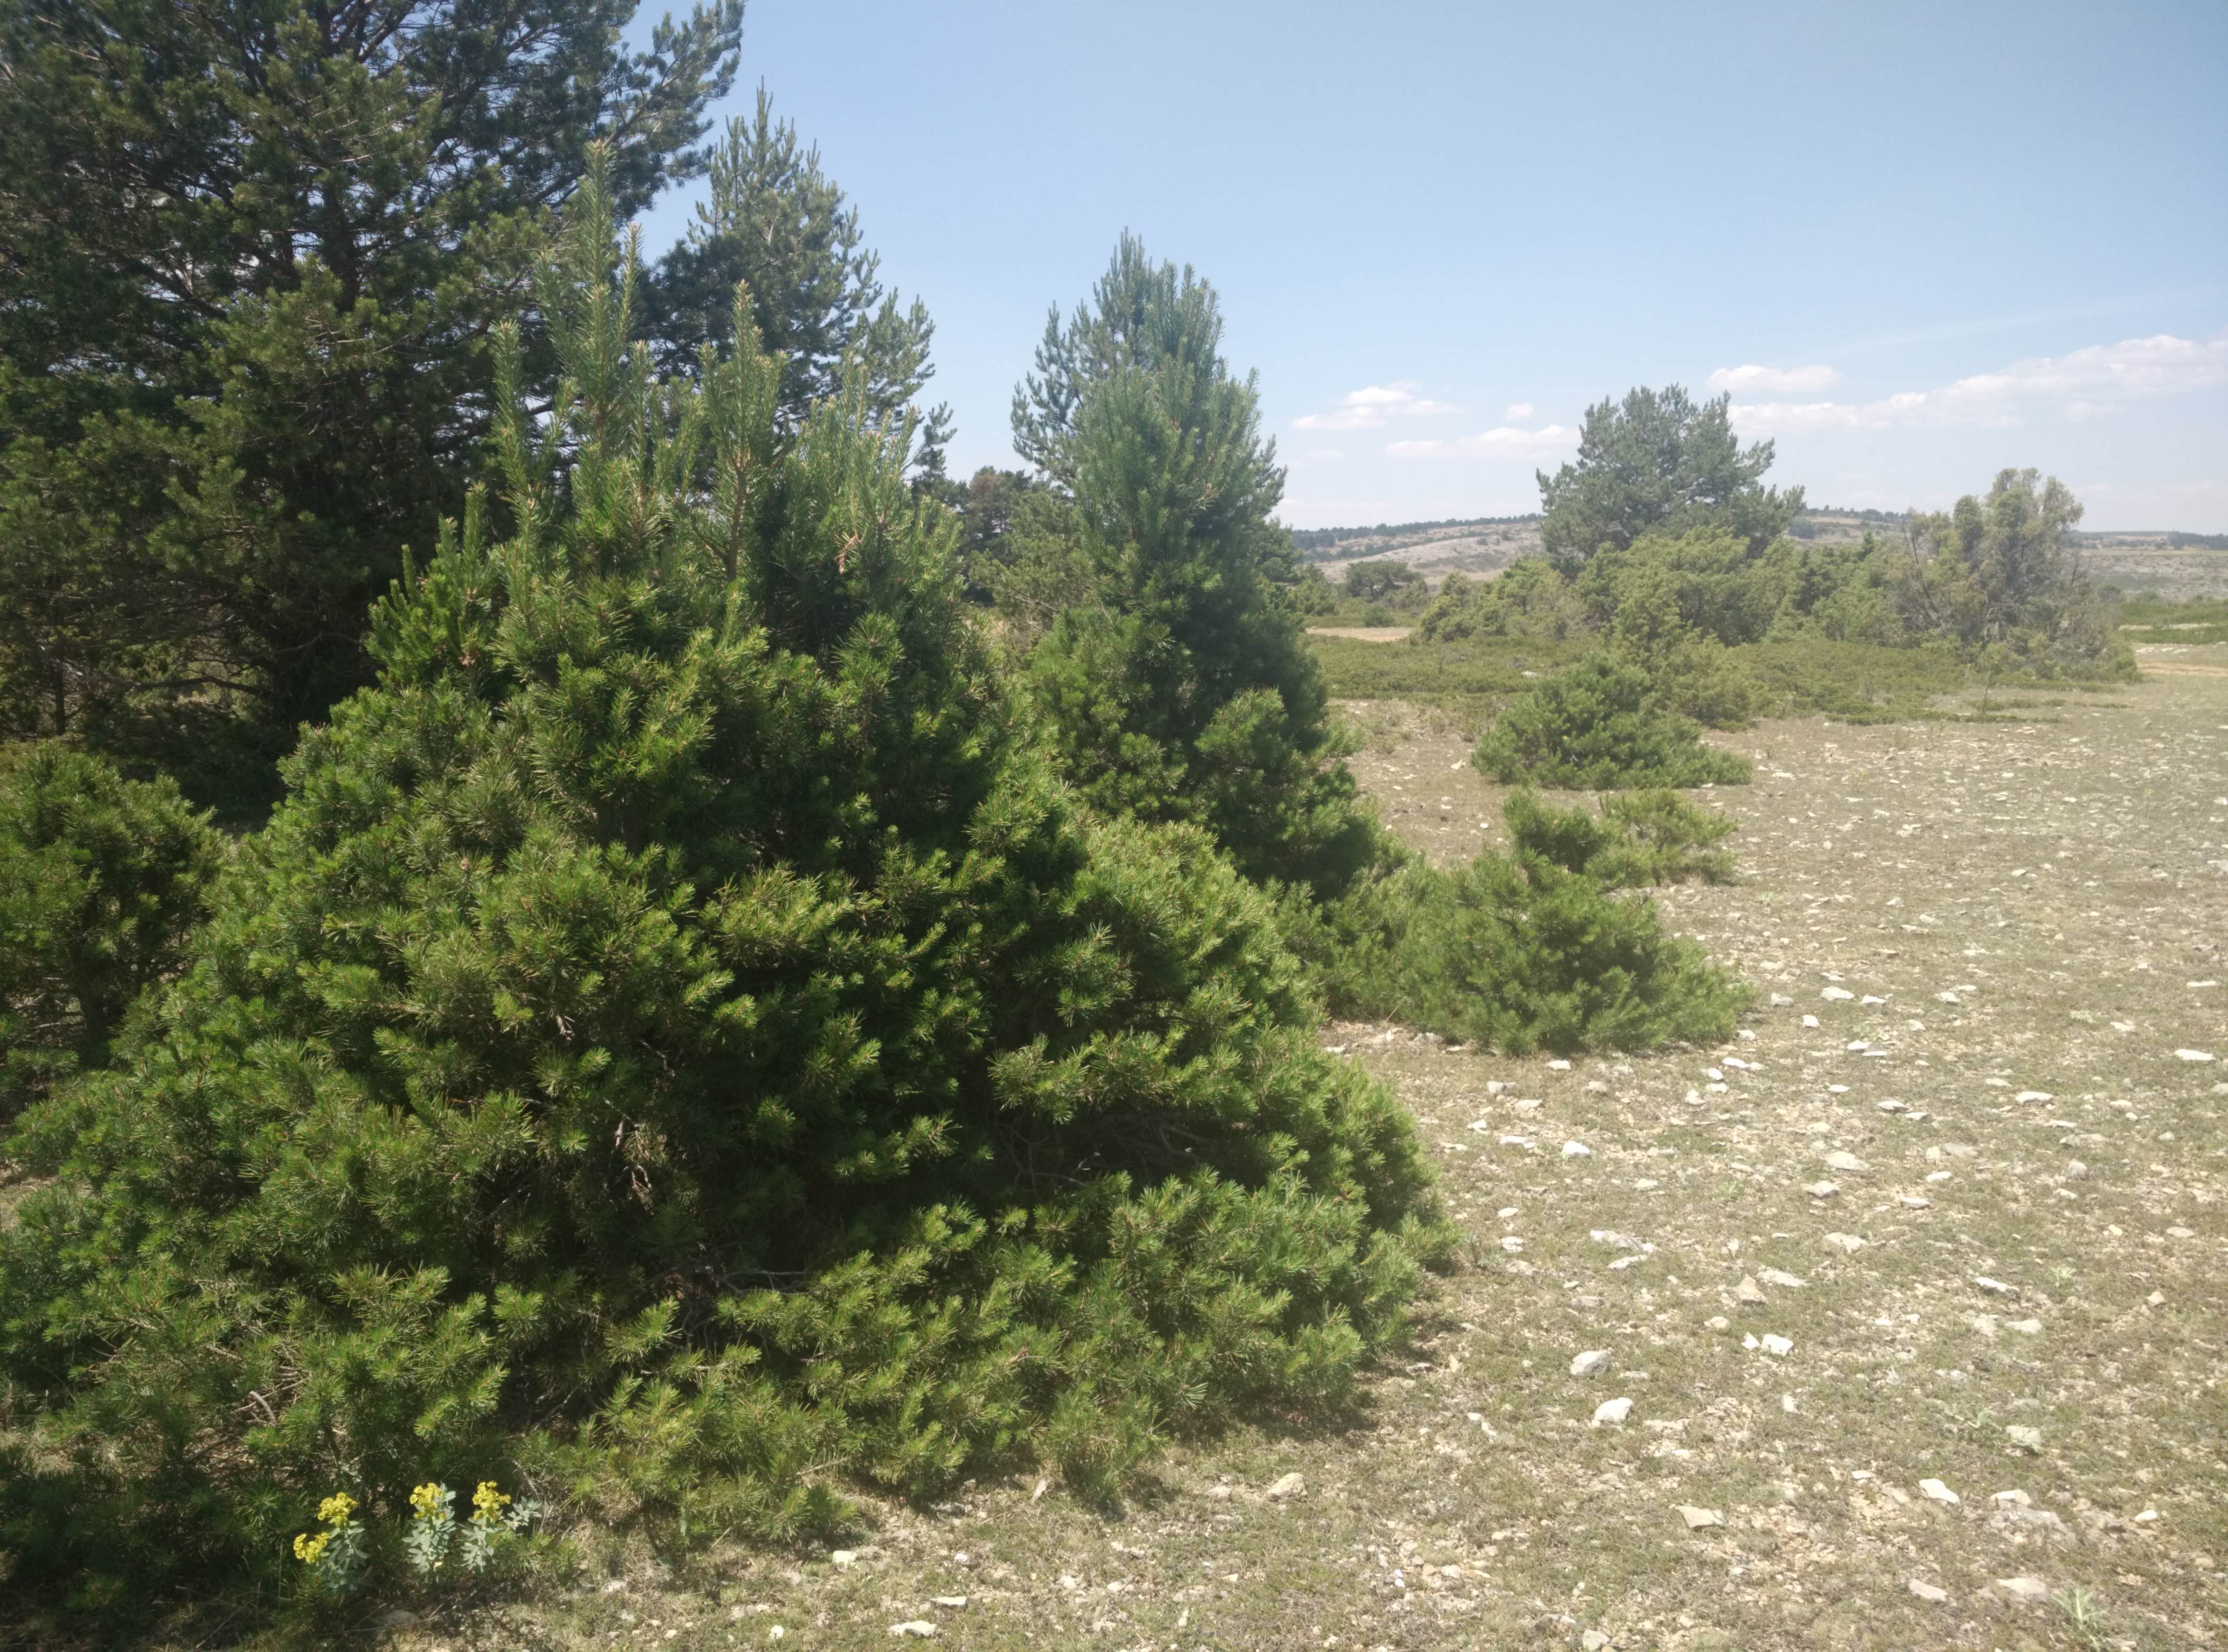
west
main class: Shrubland
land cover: Shrubland with sparse tree cover
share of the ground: 25 - 50 %
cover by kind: unconsolidated bare surface 60 %, shrubs 25 %, herbaceous plants 10 %, coniferous forest trees 5 %
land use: Semi-natural and natural areas not in use
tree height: > 5 m
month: June
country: ES
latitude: 40.5578
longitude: -1.7927
